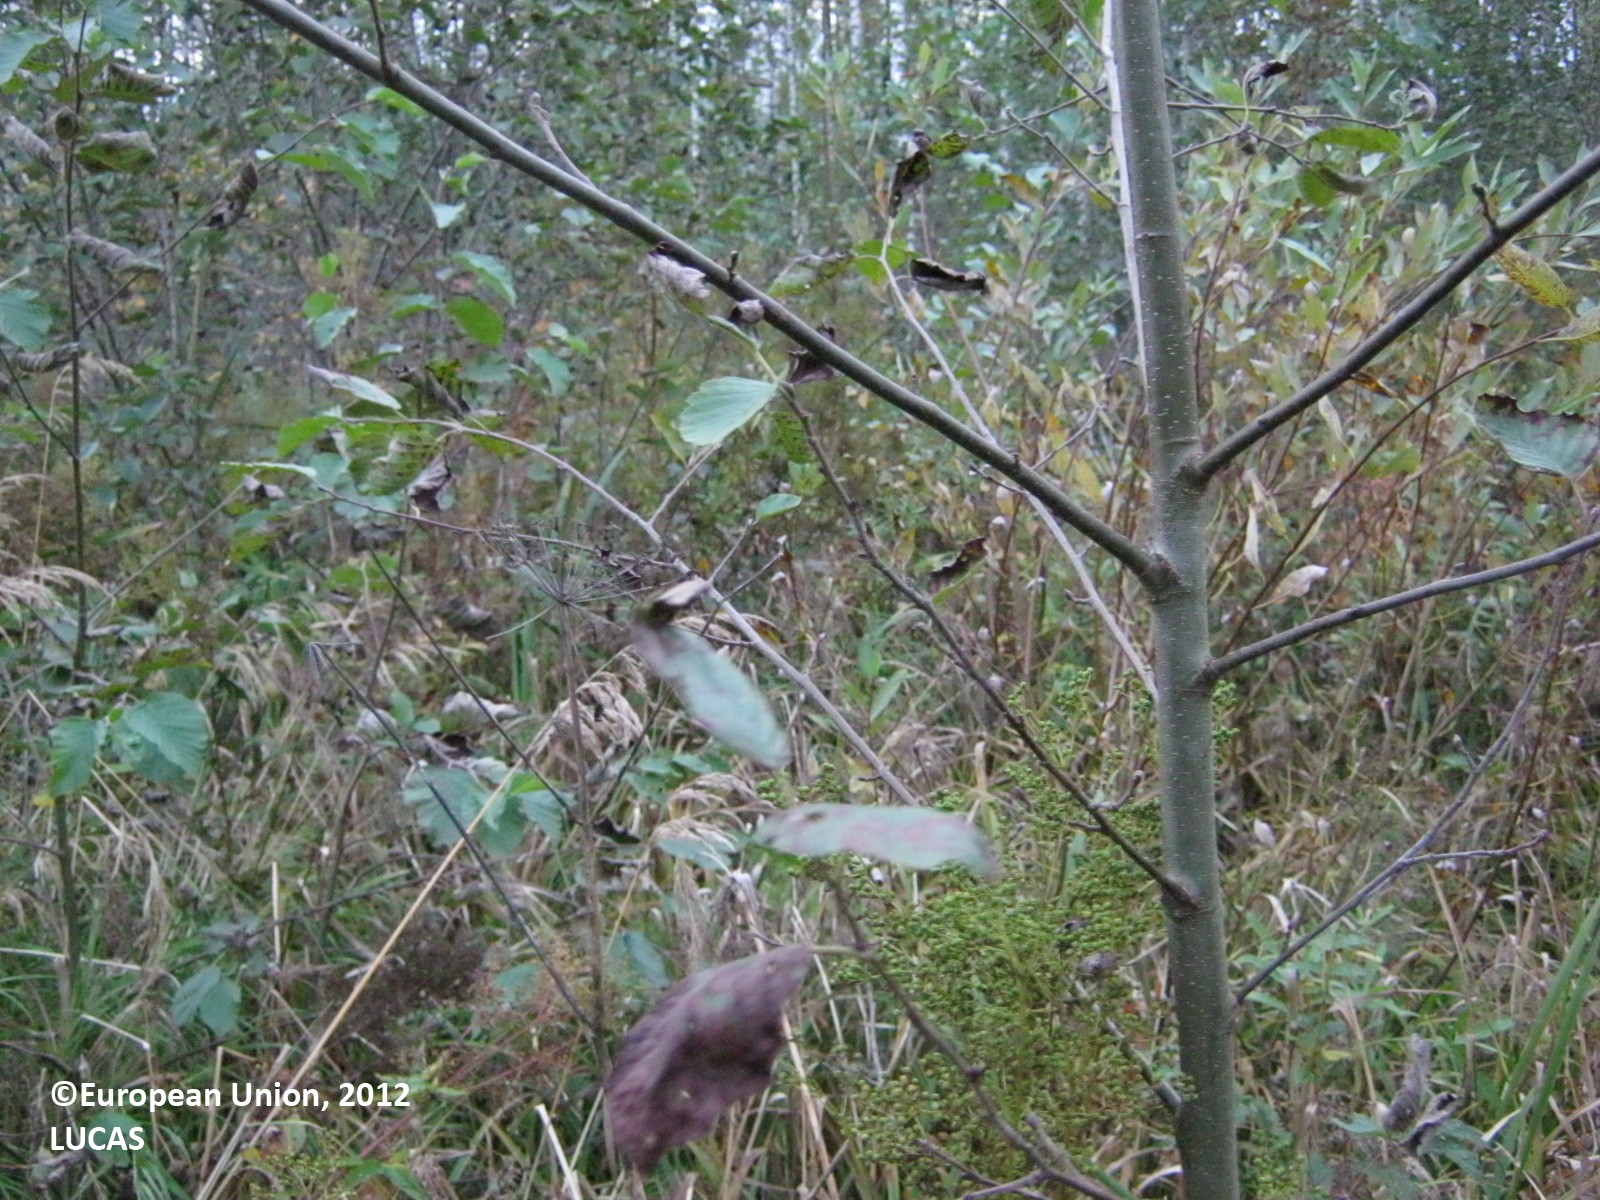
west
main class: Woodland
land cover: Broadleaved woodland
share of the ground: > 75 %
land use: Forestry
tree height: < 5 m
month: September
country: FI
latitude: 61.0083
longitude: 28.1639
